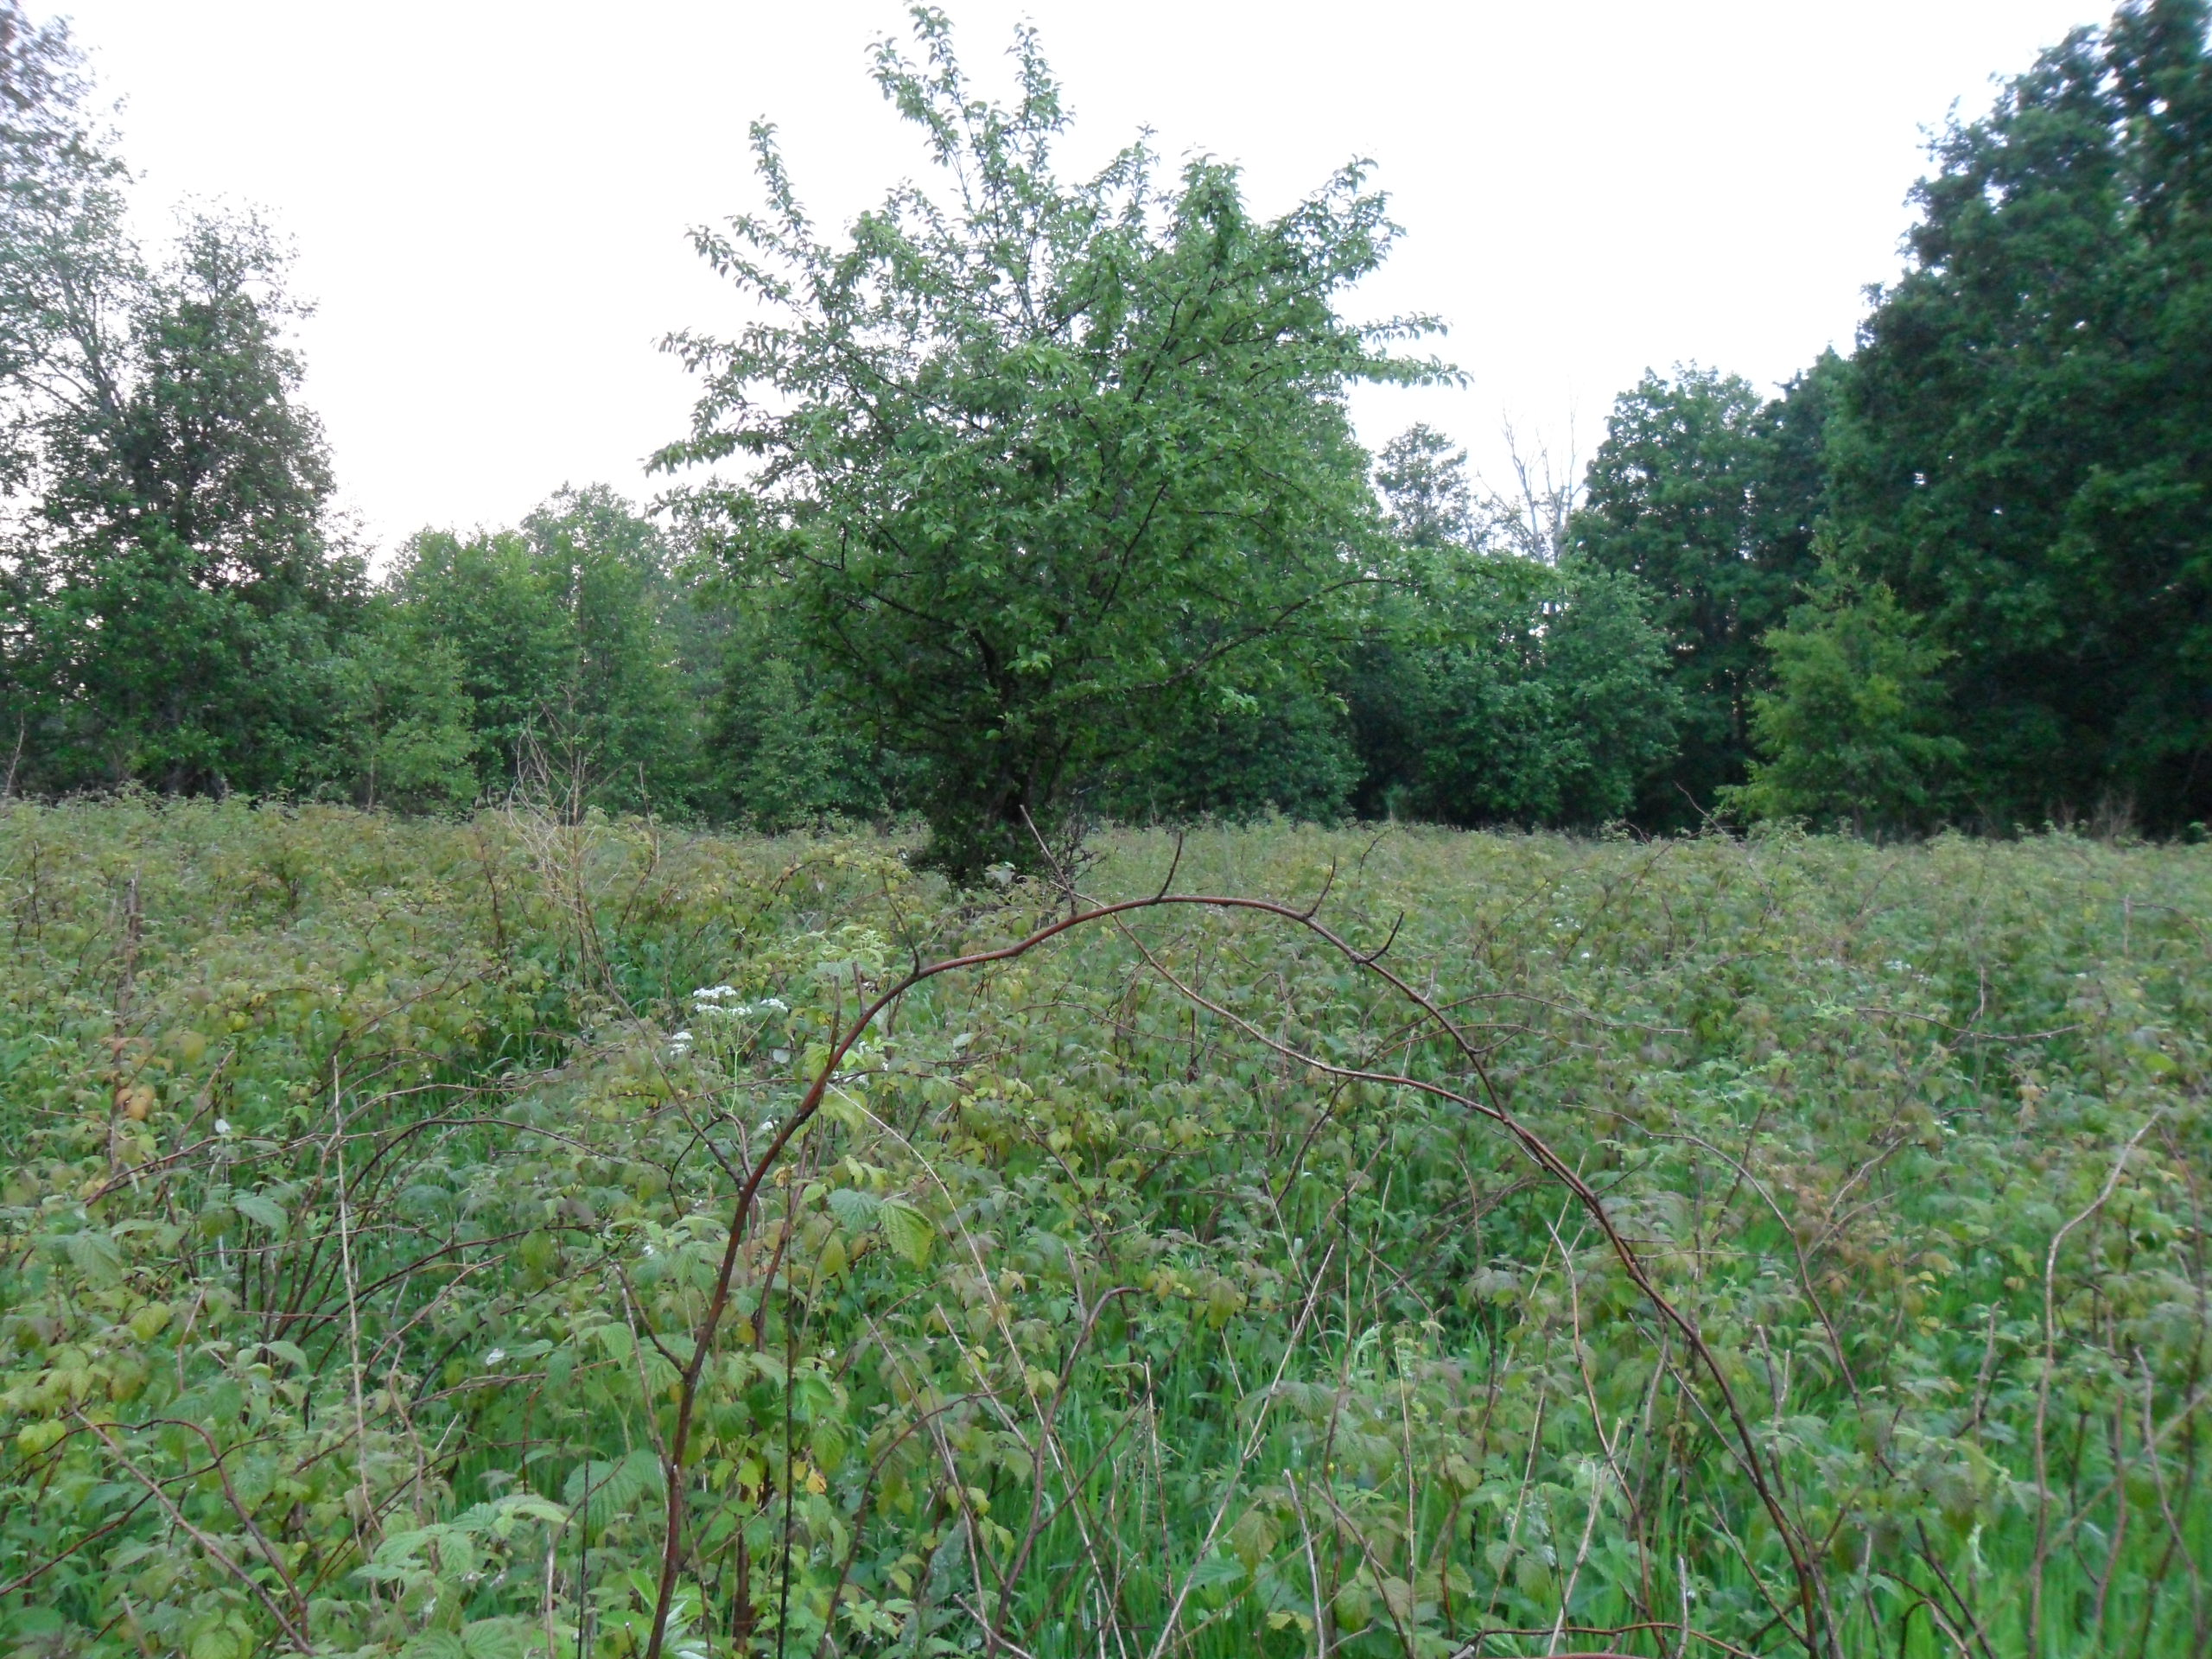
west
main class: Shrubland
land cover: Shrubland with sparse tree cover
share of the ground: > 75 %
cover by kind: shrubs 90 %, broadleaved forest trees 5 %, herbaceous plants 5 %
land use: Semi-natural and natural areas not in use
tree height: < 5 m
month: June
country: LV
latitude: 57.5026
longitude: 21.9430
